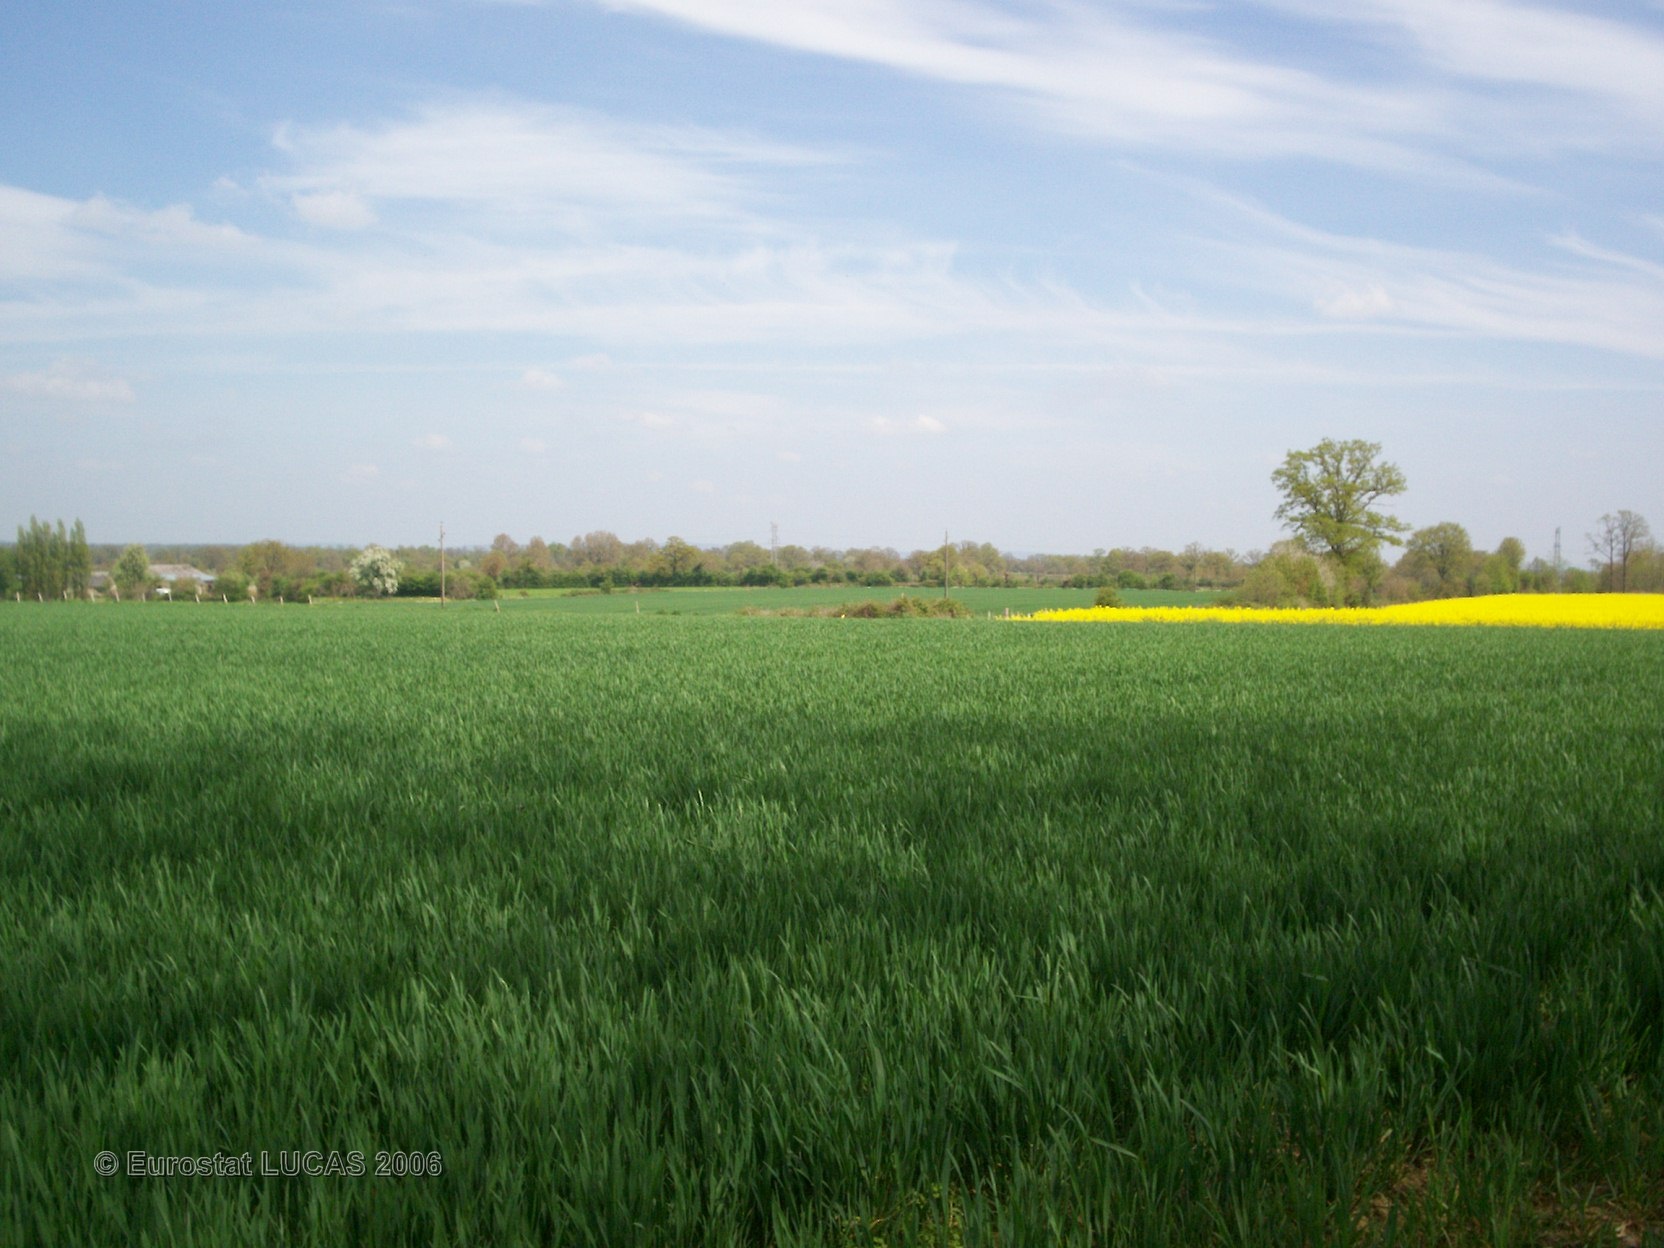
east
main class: Cropland
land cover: Common wheat
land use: Agriculture (excluding fallow land and kitchen gardens)
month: May
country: FR
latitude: 48.2139
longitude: -0.6541
